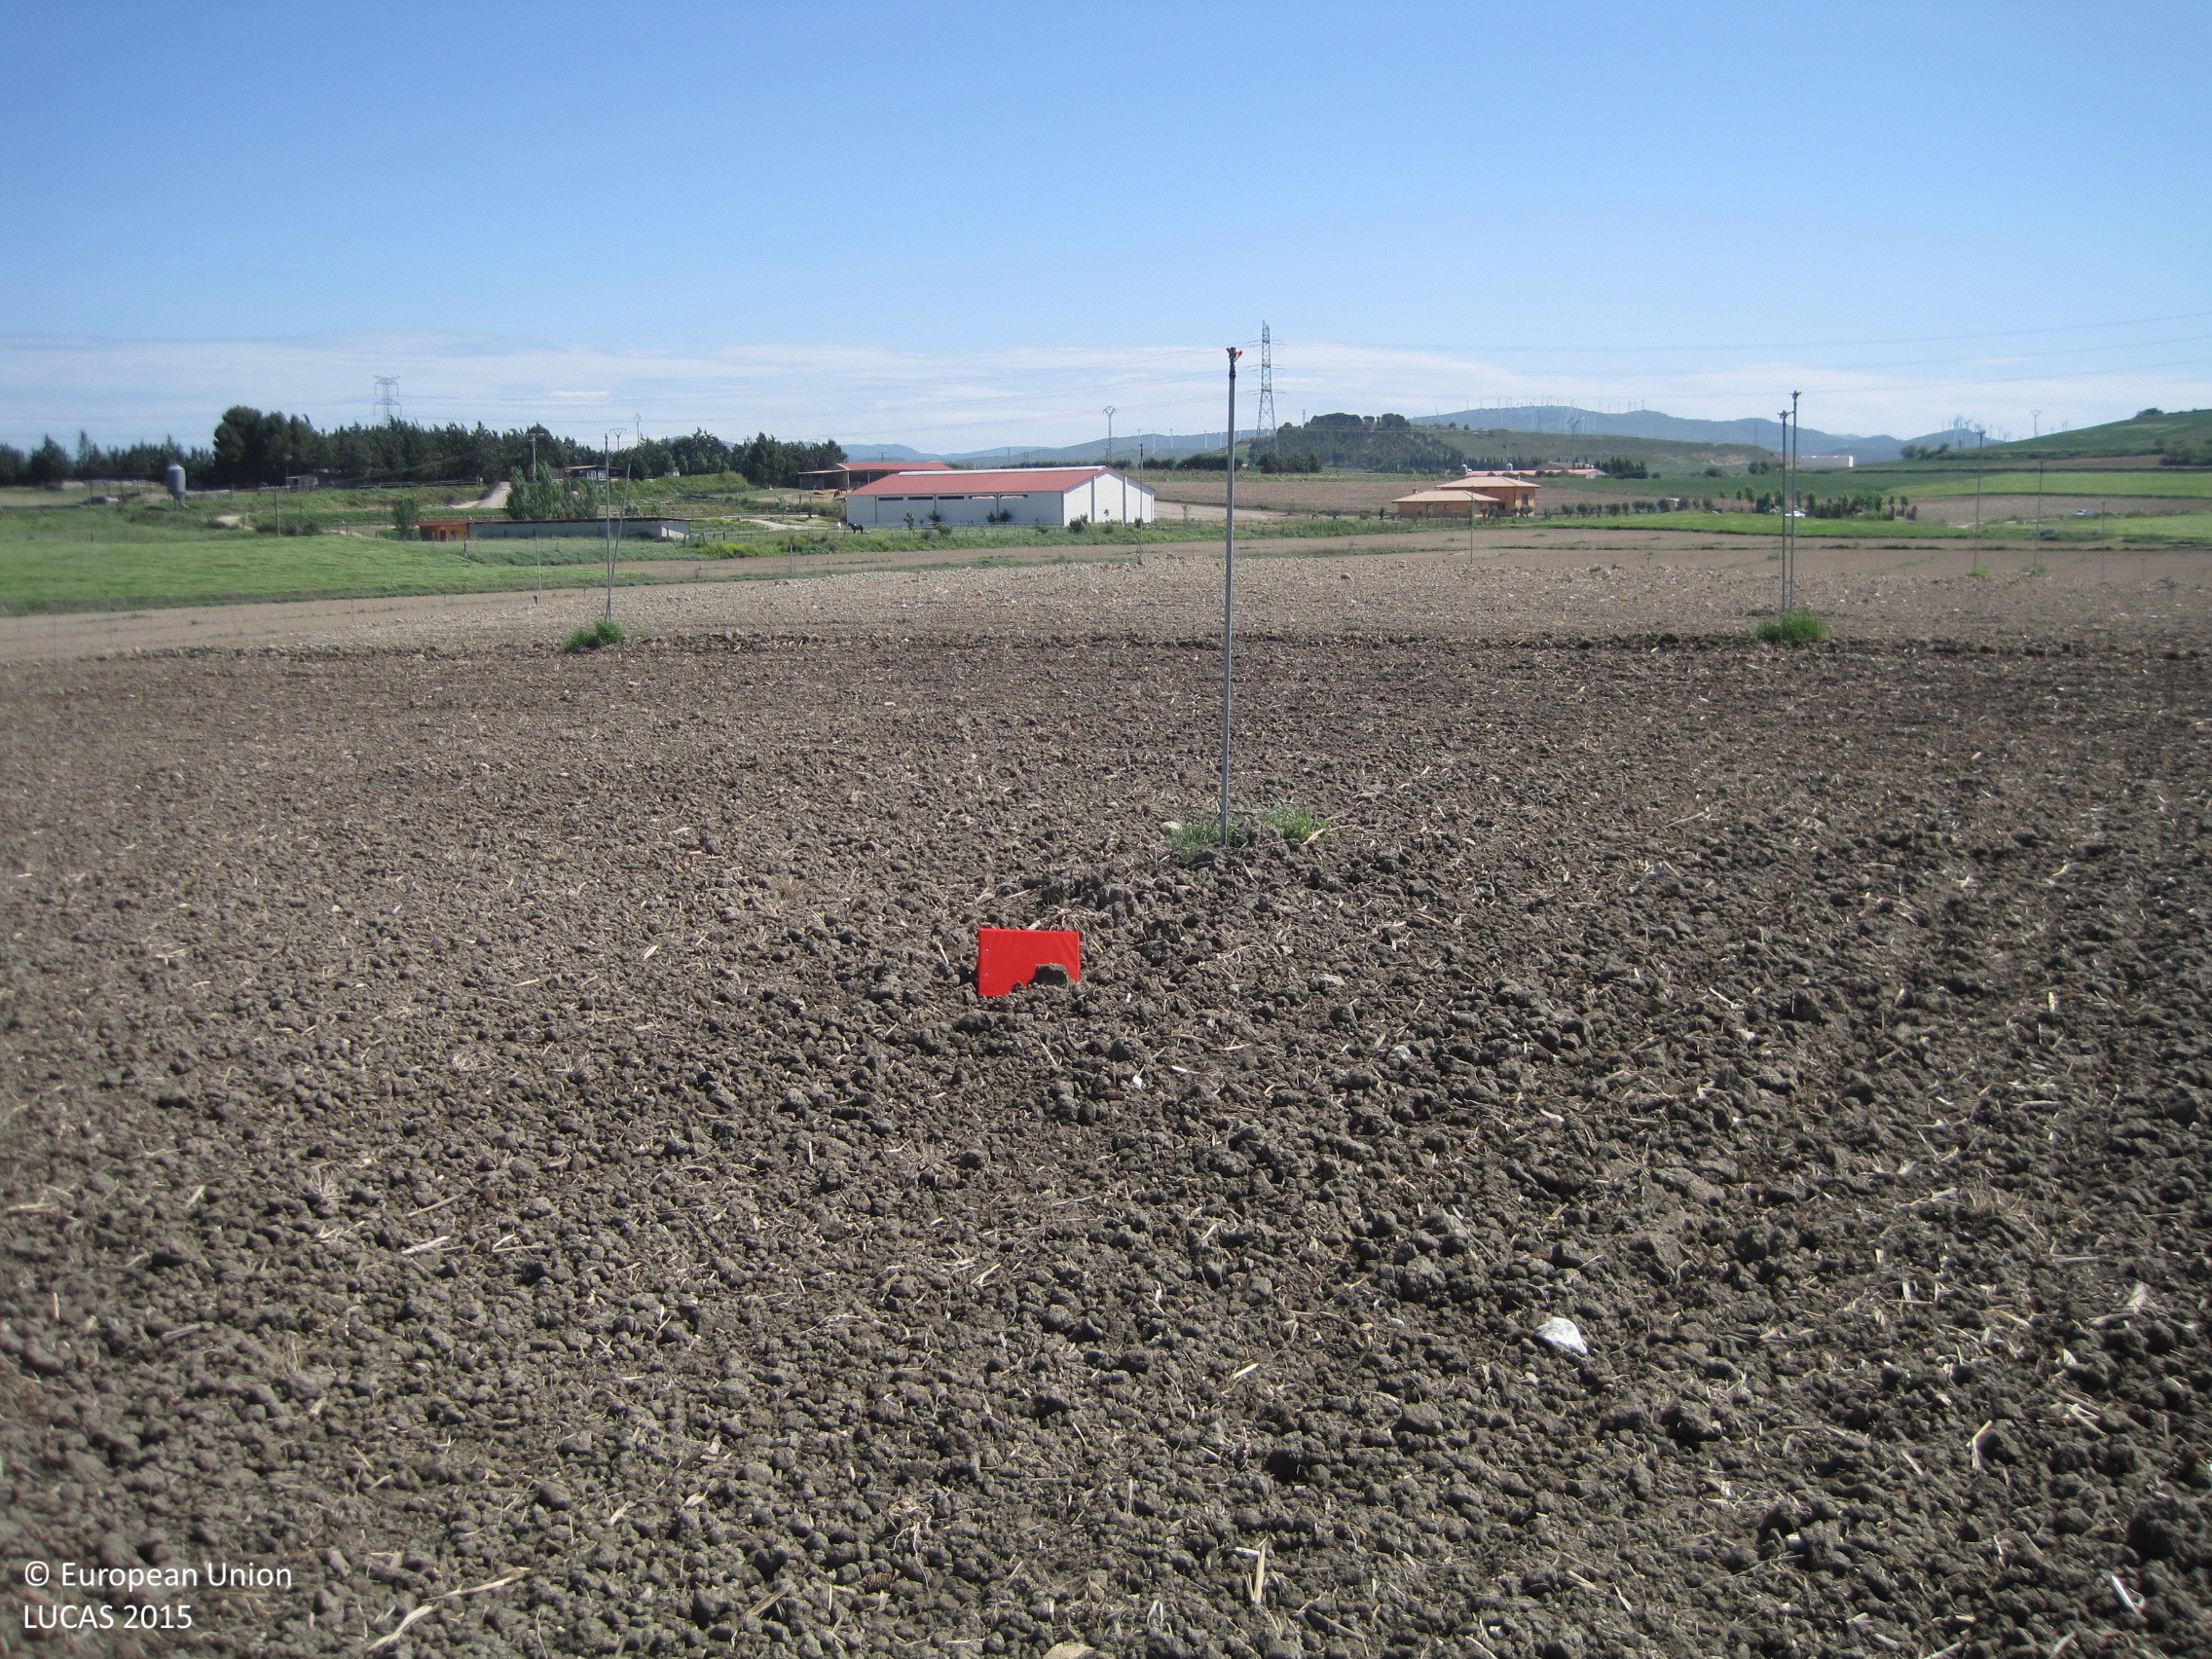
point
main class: Cropland
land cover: Maize
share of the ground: < 10 %
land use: Agriculture (excluding fallow land and kitchen gardens)
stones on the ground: < 10 %
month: May
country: ES
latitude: 42.5191
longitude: -1.7103
